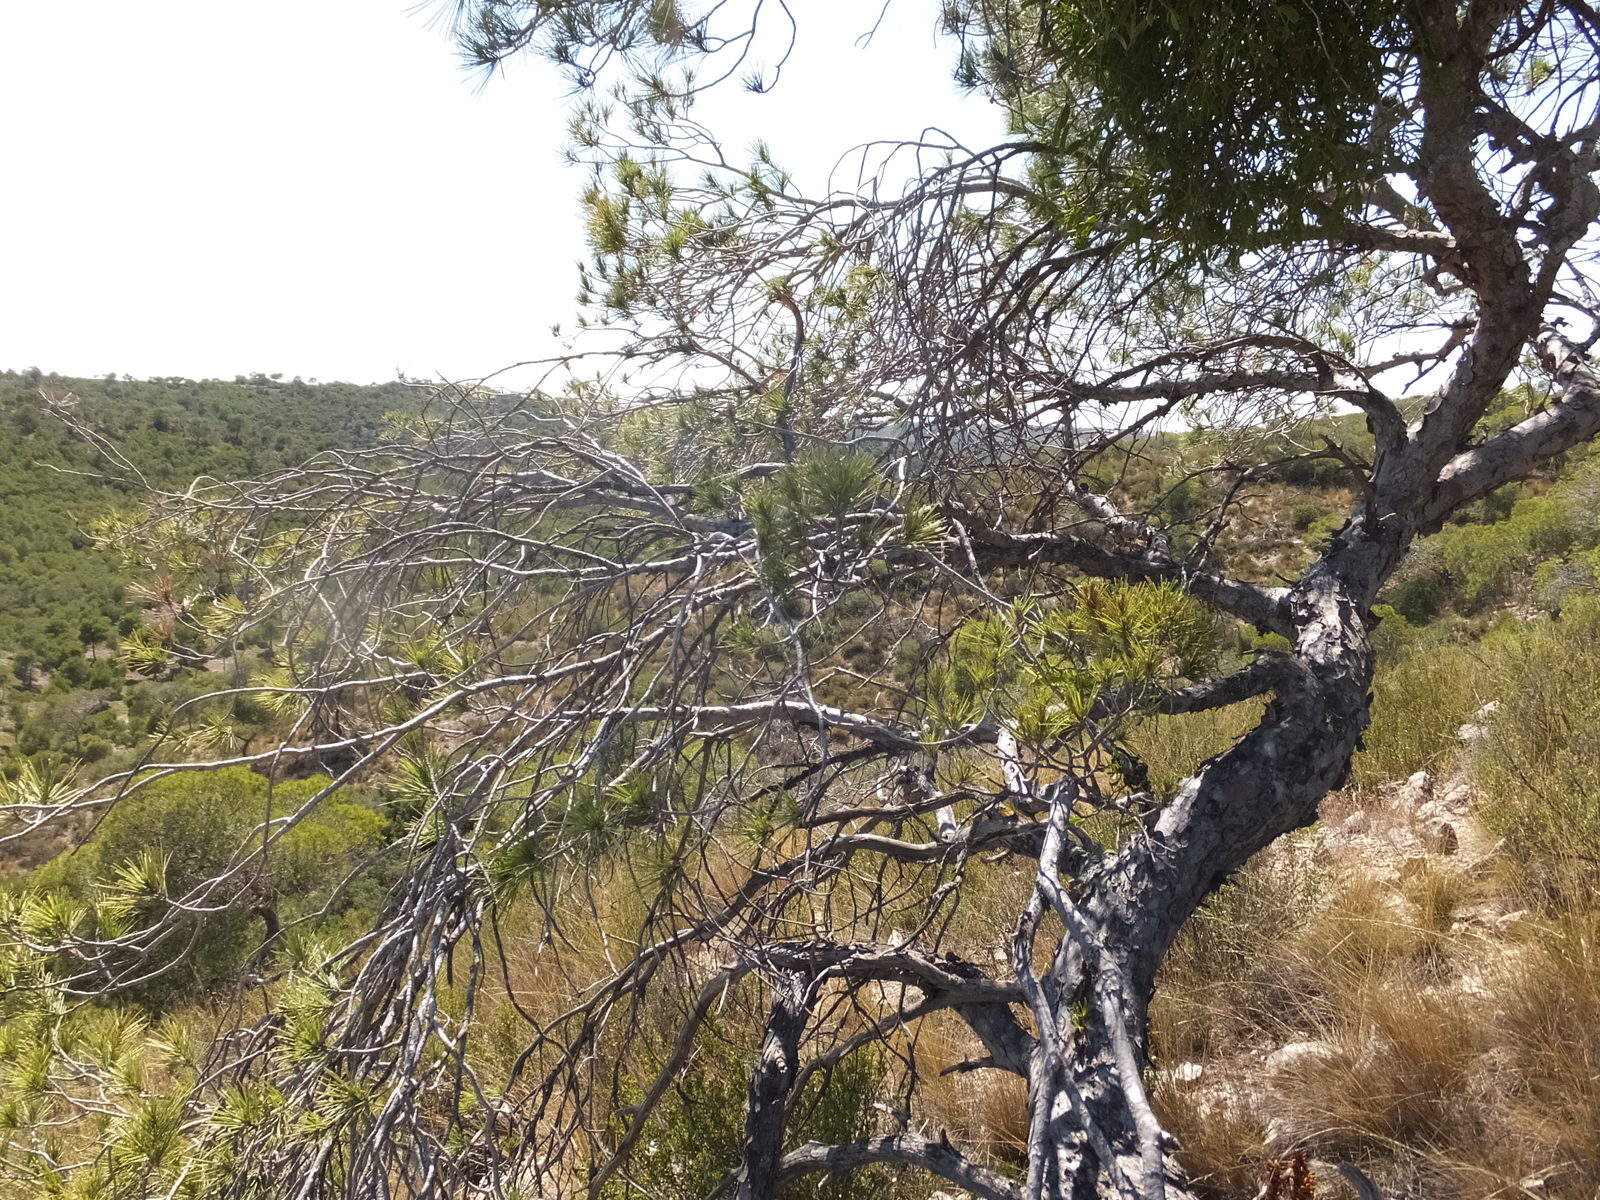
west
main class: Woodland
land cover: Pine dominated mixed woodland
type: coniferous forest of the mediterranean region
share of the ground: 25 - 50 %
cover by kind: shrubs 35 %, coniferous forest trees 25 %, herbaceous plants 25 %, broadleaved forest trees 15 %
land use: Forestry
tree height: > 5 m
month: June
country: ES
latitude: 41.3509
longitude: -0.0654
